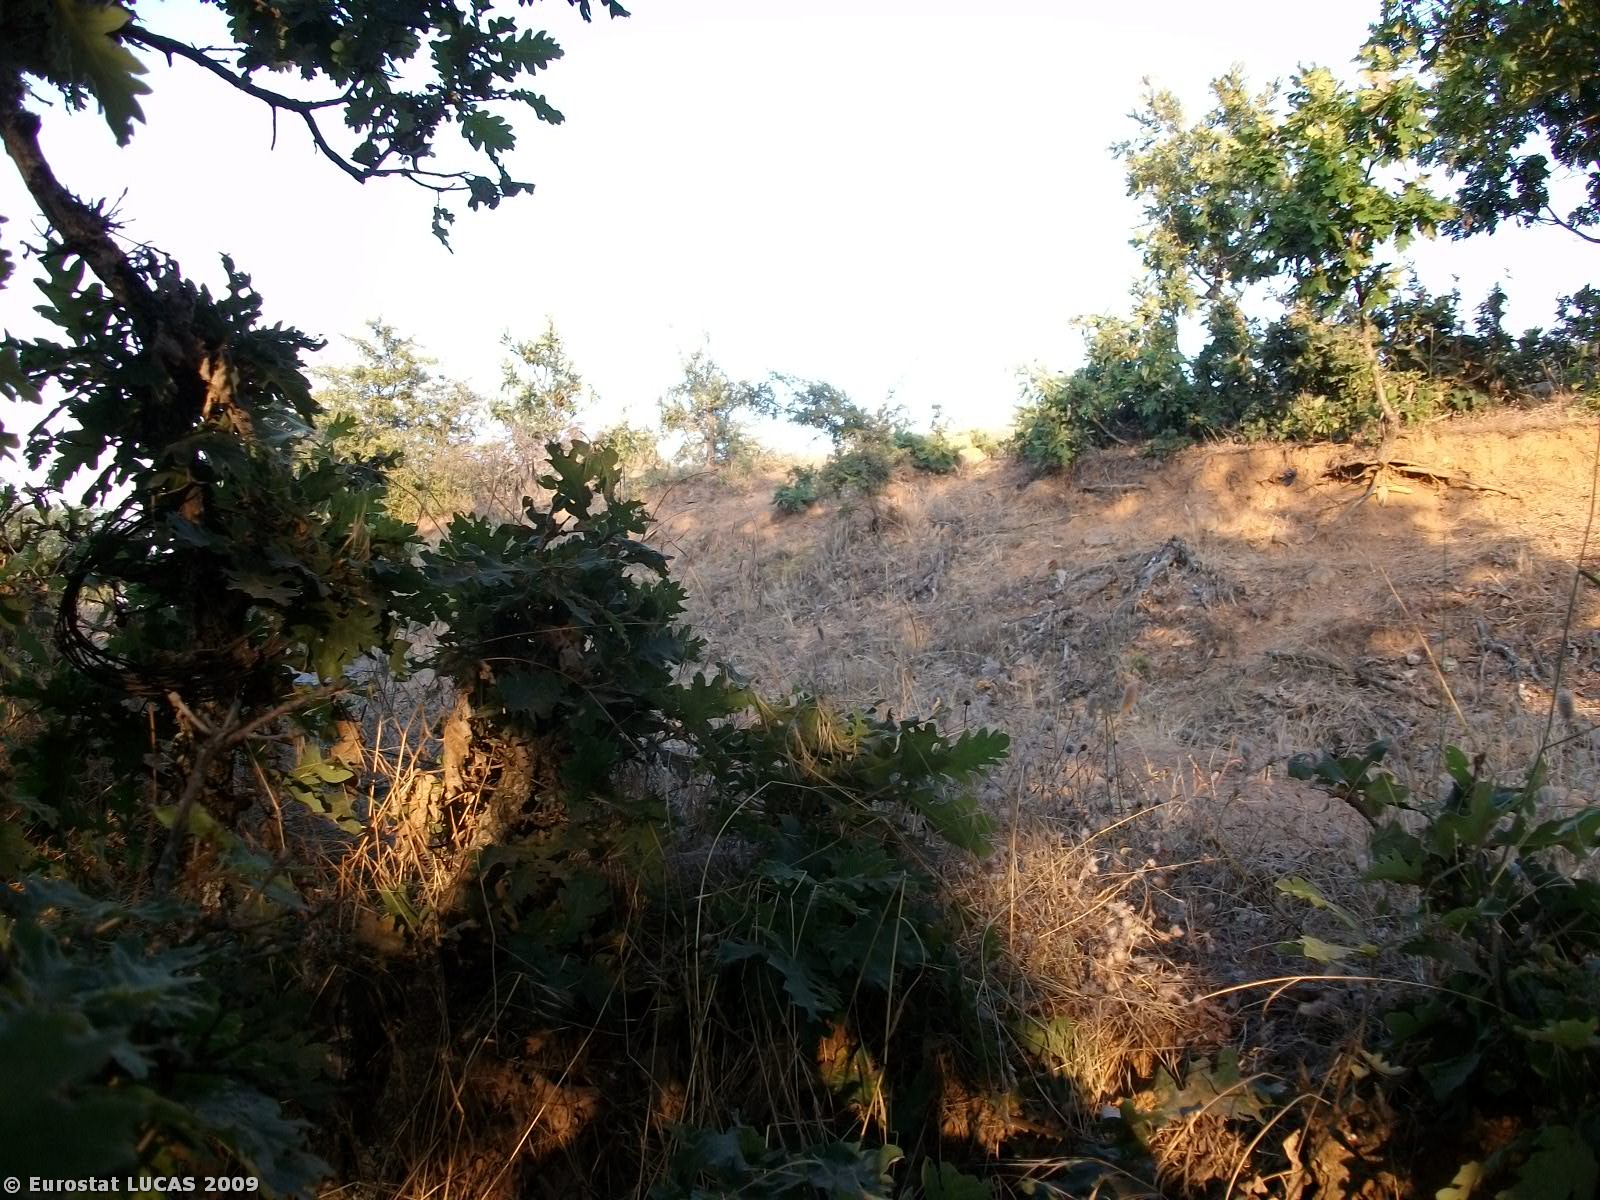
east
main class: Woodland
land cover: Broadleaved woodland
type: thermophilous deciduous forest
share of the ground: > 75 %
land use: Forestry
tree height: > 5 m
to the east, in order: Broadleaved woodland; Tracks; Grassland with sparse tree/shrub cover; Tracks; Abandoned hedges; Grassland without tree/shrub cover; Grassland with sparse tree/shrub cover
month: July
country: GR
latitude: 39.8502
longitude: 21.7562
